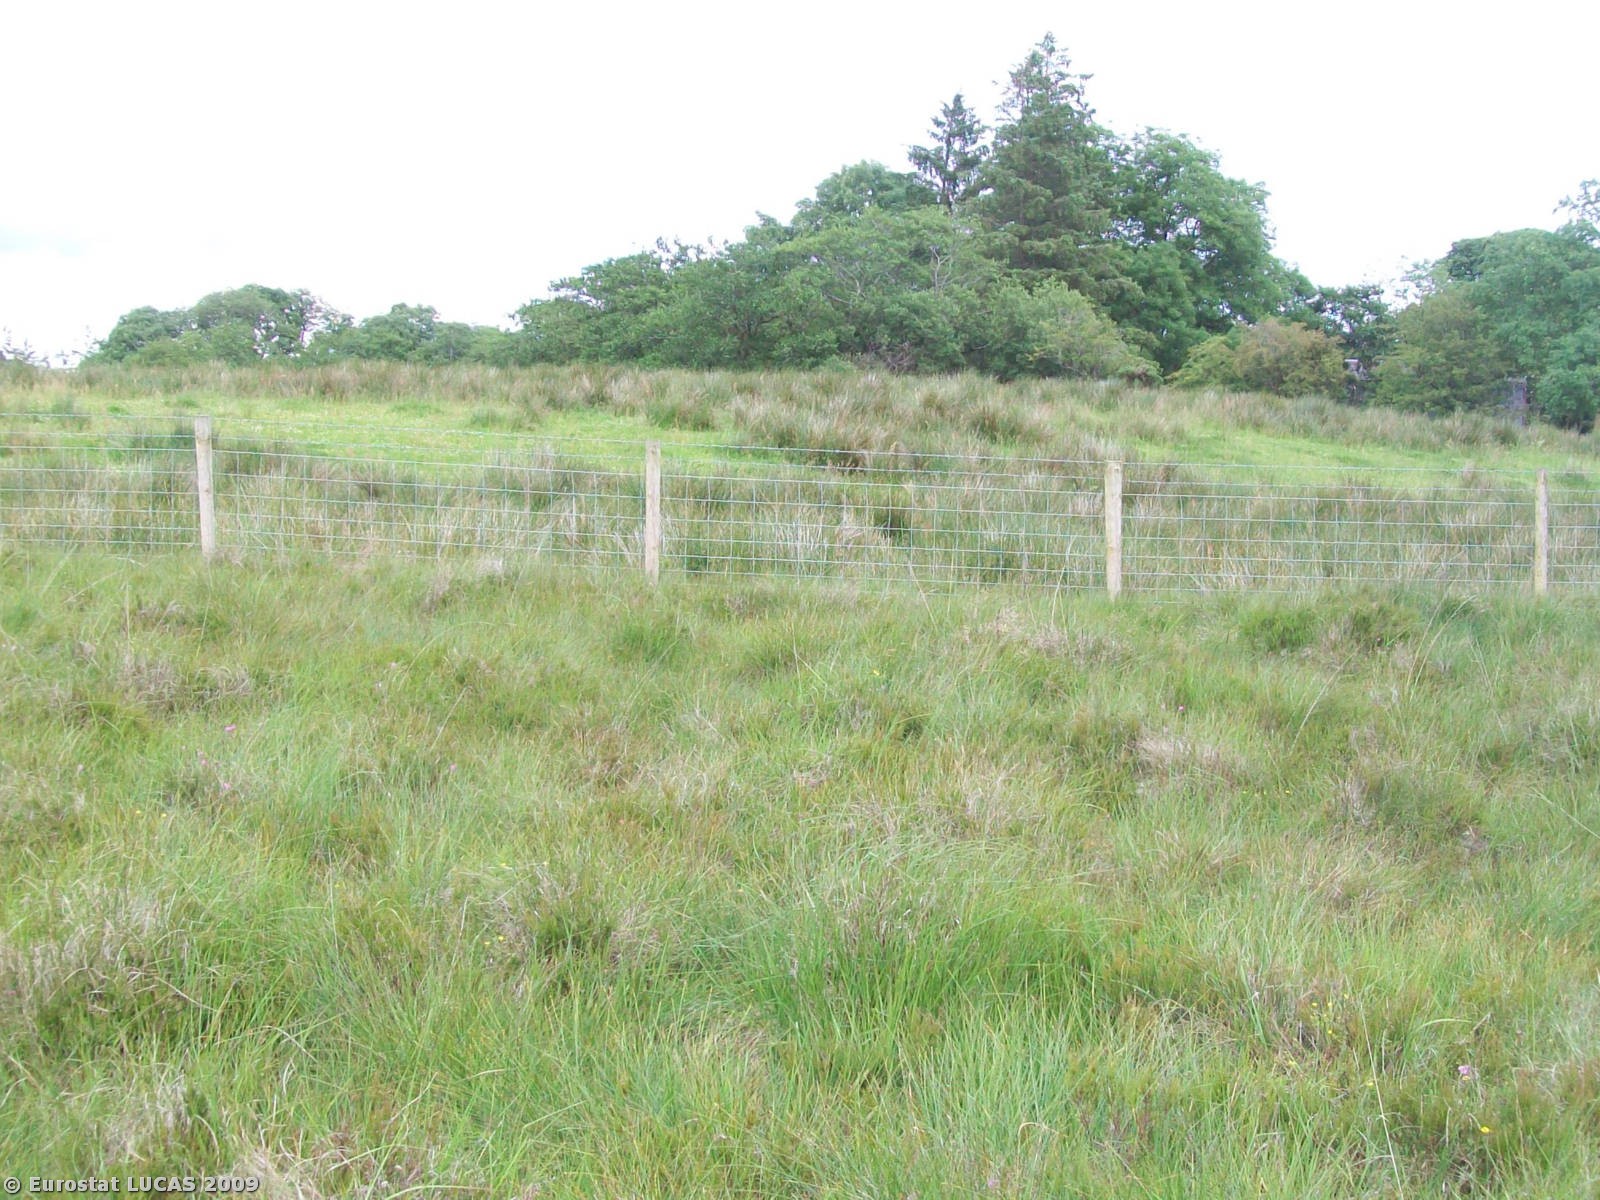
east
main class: Wetlands
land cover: Peatbogs
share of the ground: > 75 %
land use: Unused
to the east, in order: Peatbogs; Fences; Peatbogs; Grassland without tree/shrub cover; Abandoned hedges; Grassland without tree/shrub cover; Broadleaved woodland; Grass margins; Artificial constructions in urban areas; Broadleaved woodland; Grass margins; Paved roads, cycling and walking lanes; Grass margins; Fences; Broadleaved woodland; Grassland without tree/shrub cover; Electric lines; Grassland without tree/shrub cover
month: July
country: GB
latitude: 54.7159
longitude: -6.9491
